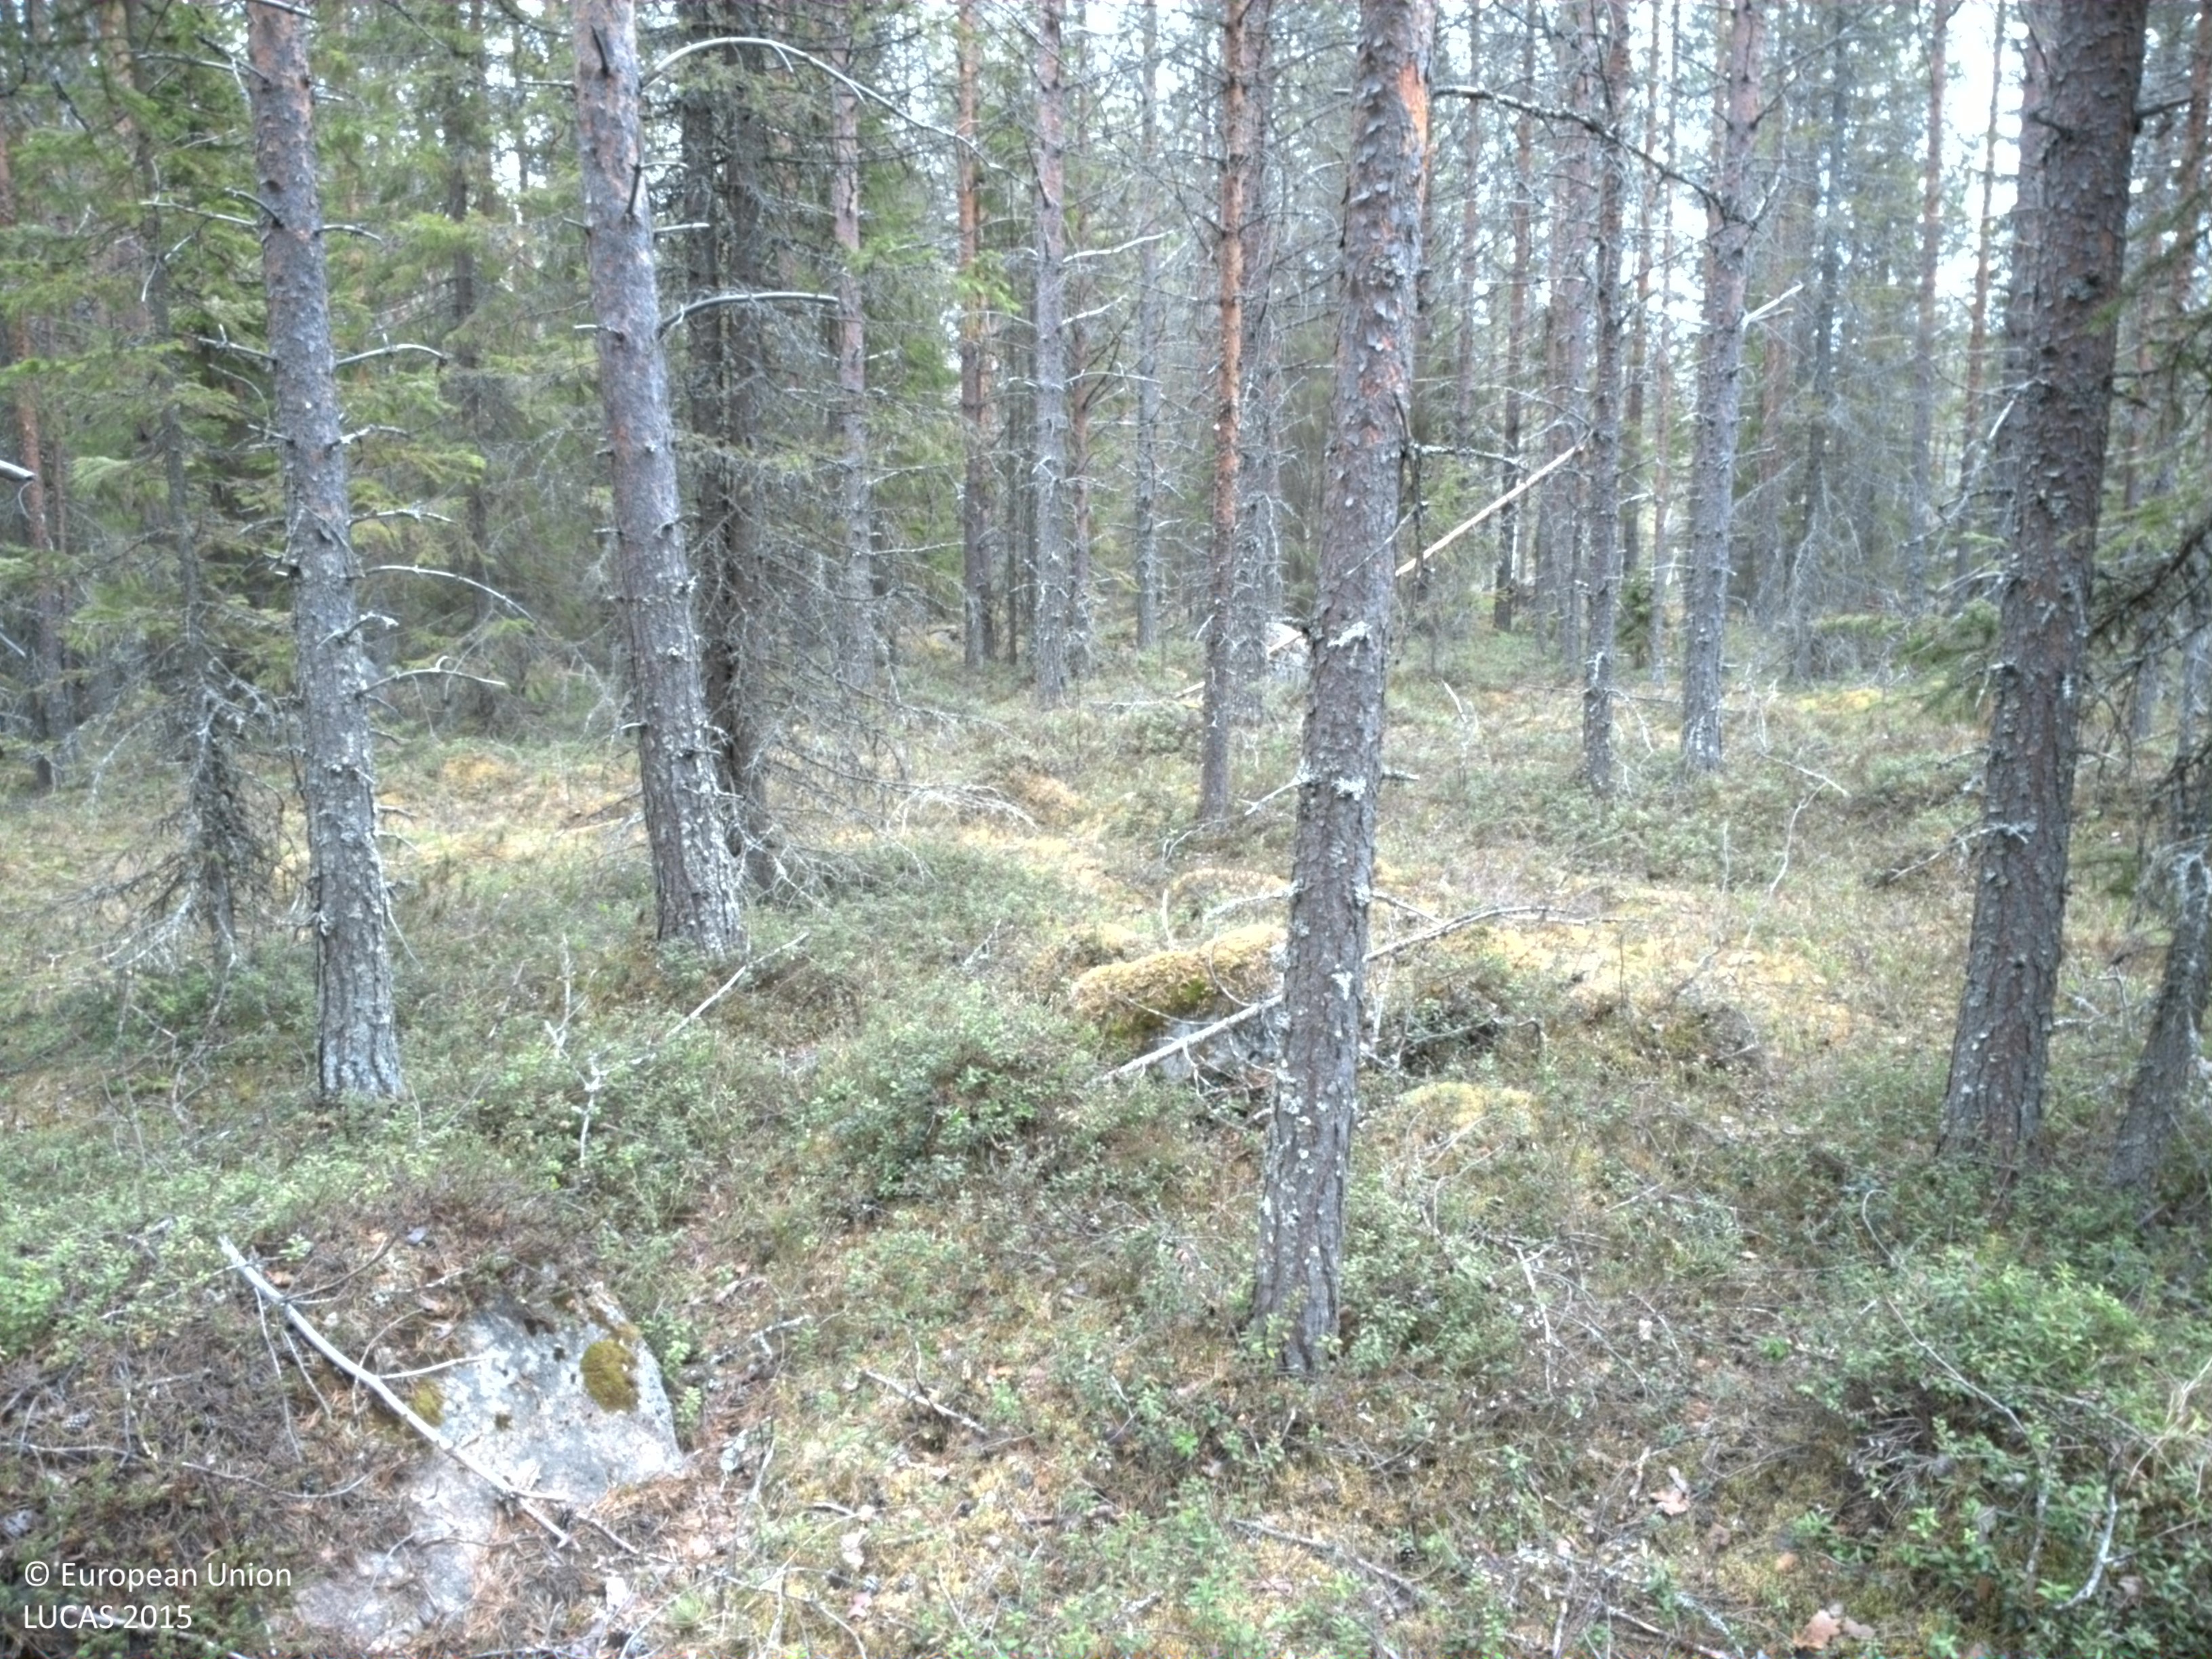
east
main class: Woodland
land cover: Pine dominated coniferous woodland
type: boreal forest
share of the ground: 50 - 75 %
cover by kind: coniferous forest trees 60 %, shrubs 35 %, lichens and mosses 5 %
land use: Forestry
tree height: > 5 m
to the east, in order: Pine dominated coniferous woodland; Broadleaved woodland; Inland fresh running water; Spruce dominated mixed woodland; Pine dominated coniferous woodland
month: May
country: SE
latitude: 66.0034
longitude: 23.3203
